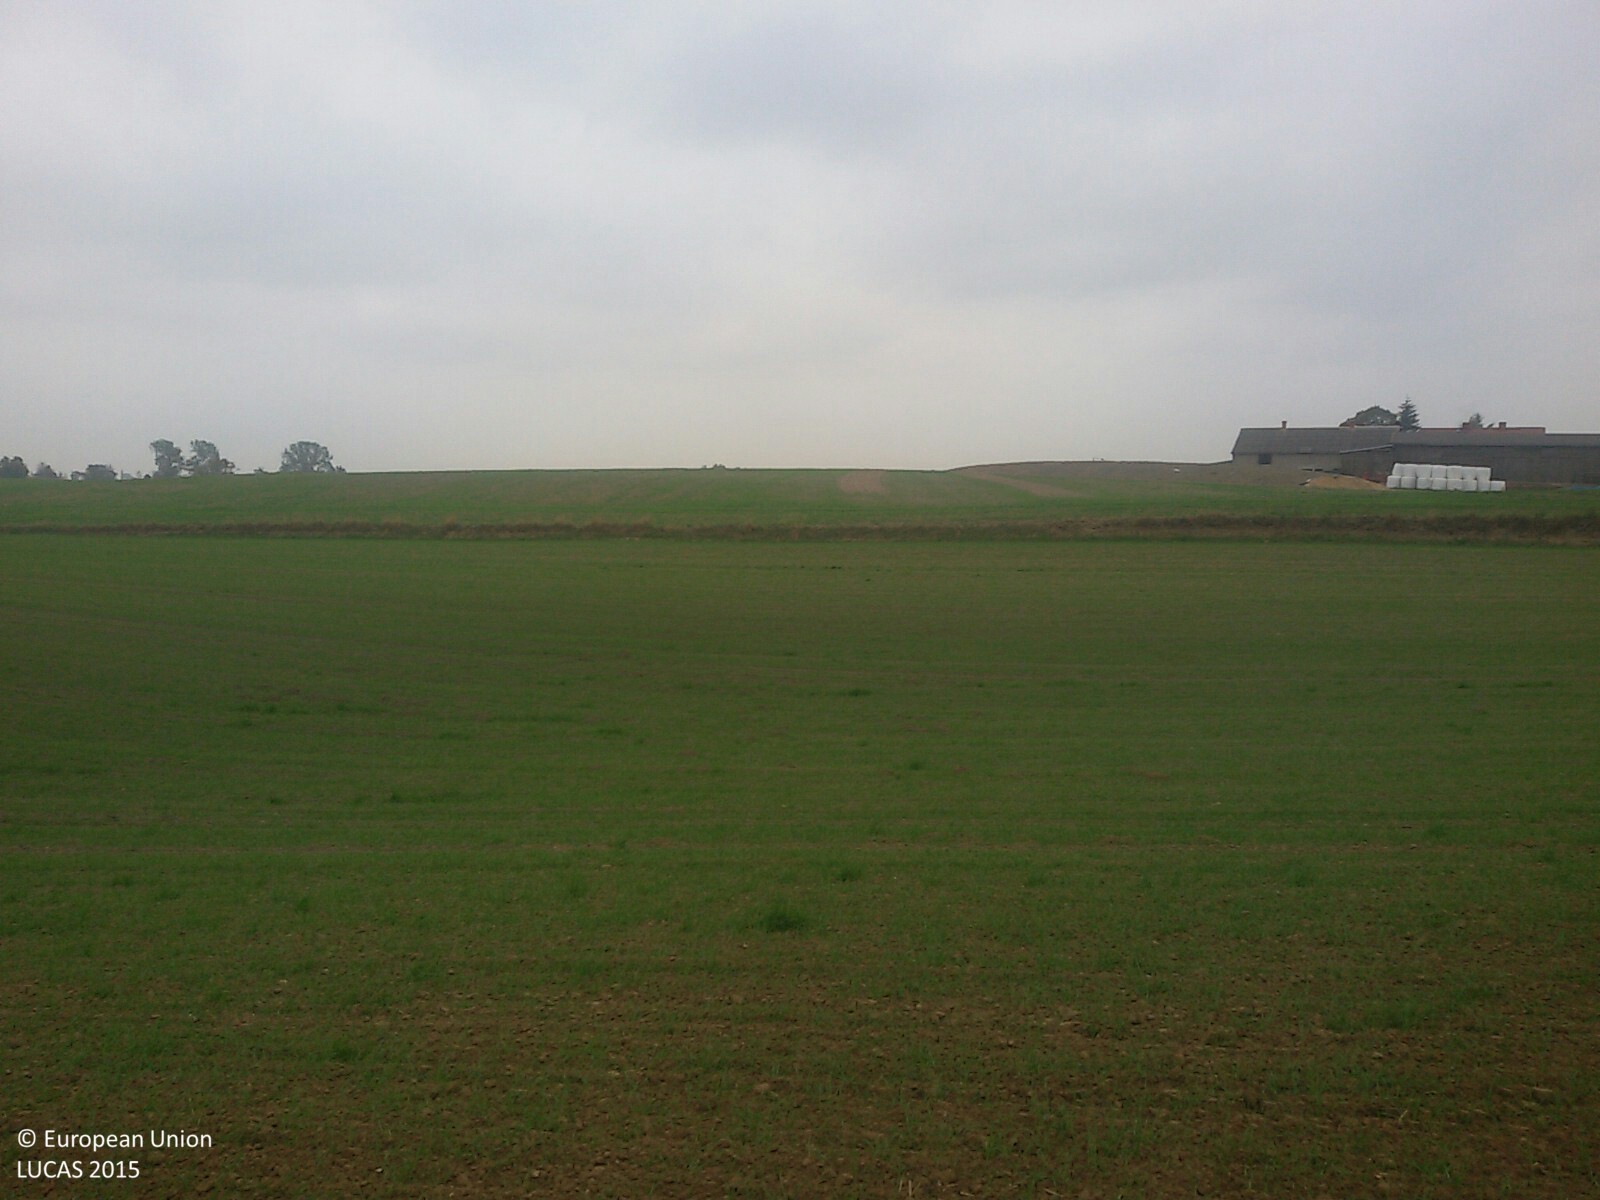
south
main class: Cropland
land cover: Common wheat
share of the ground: < 10 %
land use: Agriculture (excluding fallow land and kitchen gardens)
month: October
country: PL
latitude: 53.3050
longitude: 19.1932
